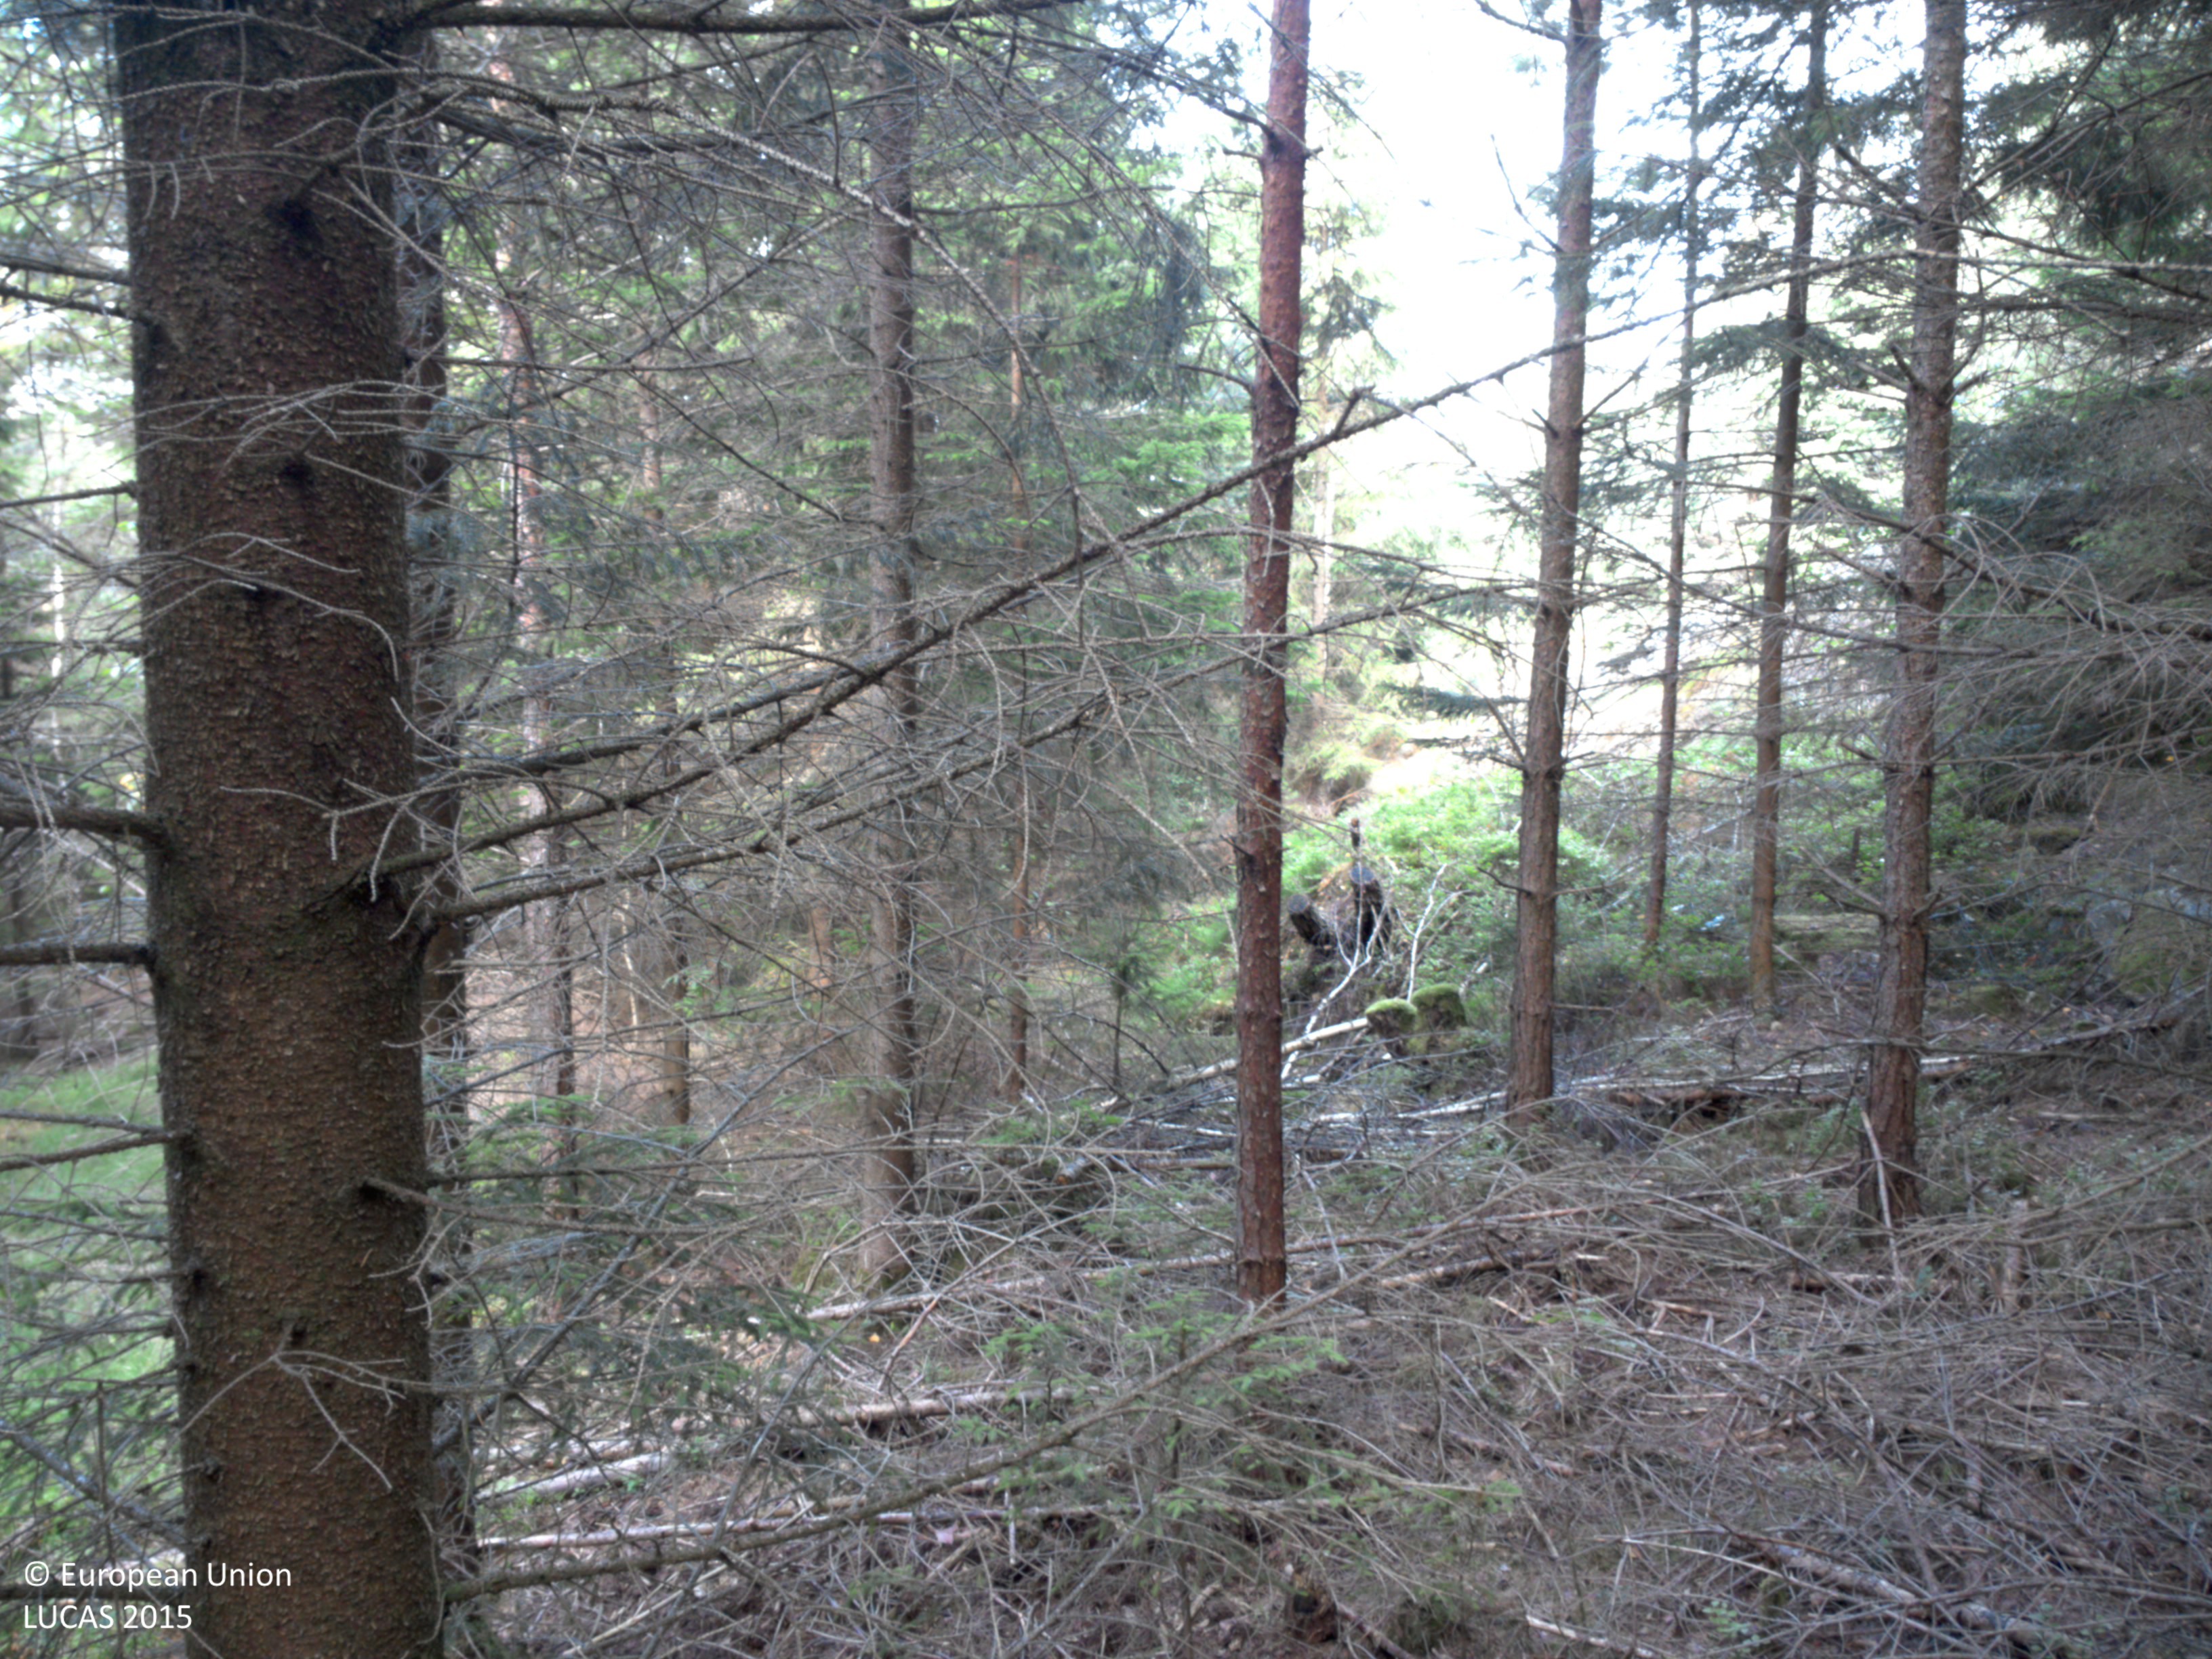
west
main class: Woodland
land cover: Other coniferous woodland
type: boreal forest
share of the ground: > 75 %
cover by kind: coniferous forest trees 90 %, shrubs 5 %, lichens and mosses 5 %
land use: Forestry
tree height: > 5 m
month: August
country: SE
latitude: 58.0076
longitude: 11.9426
